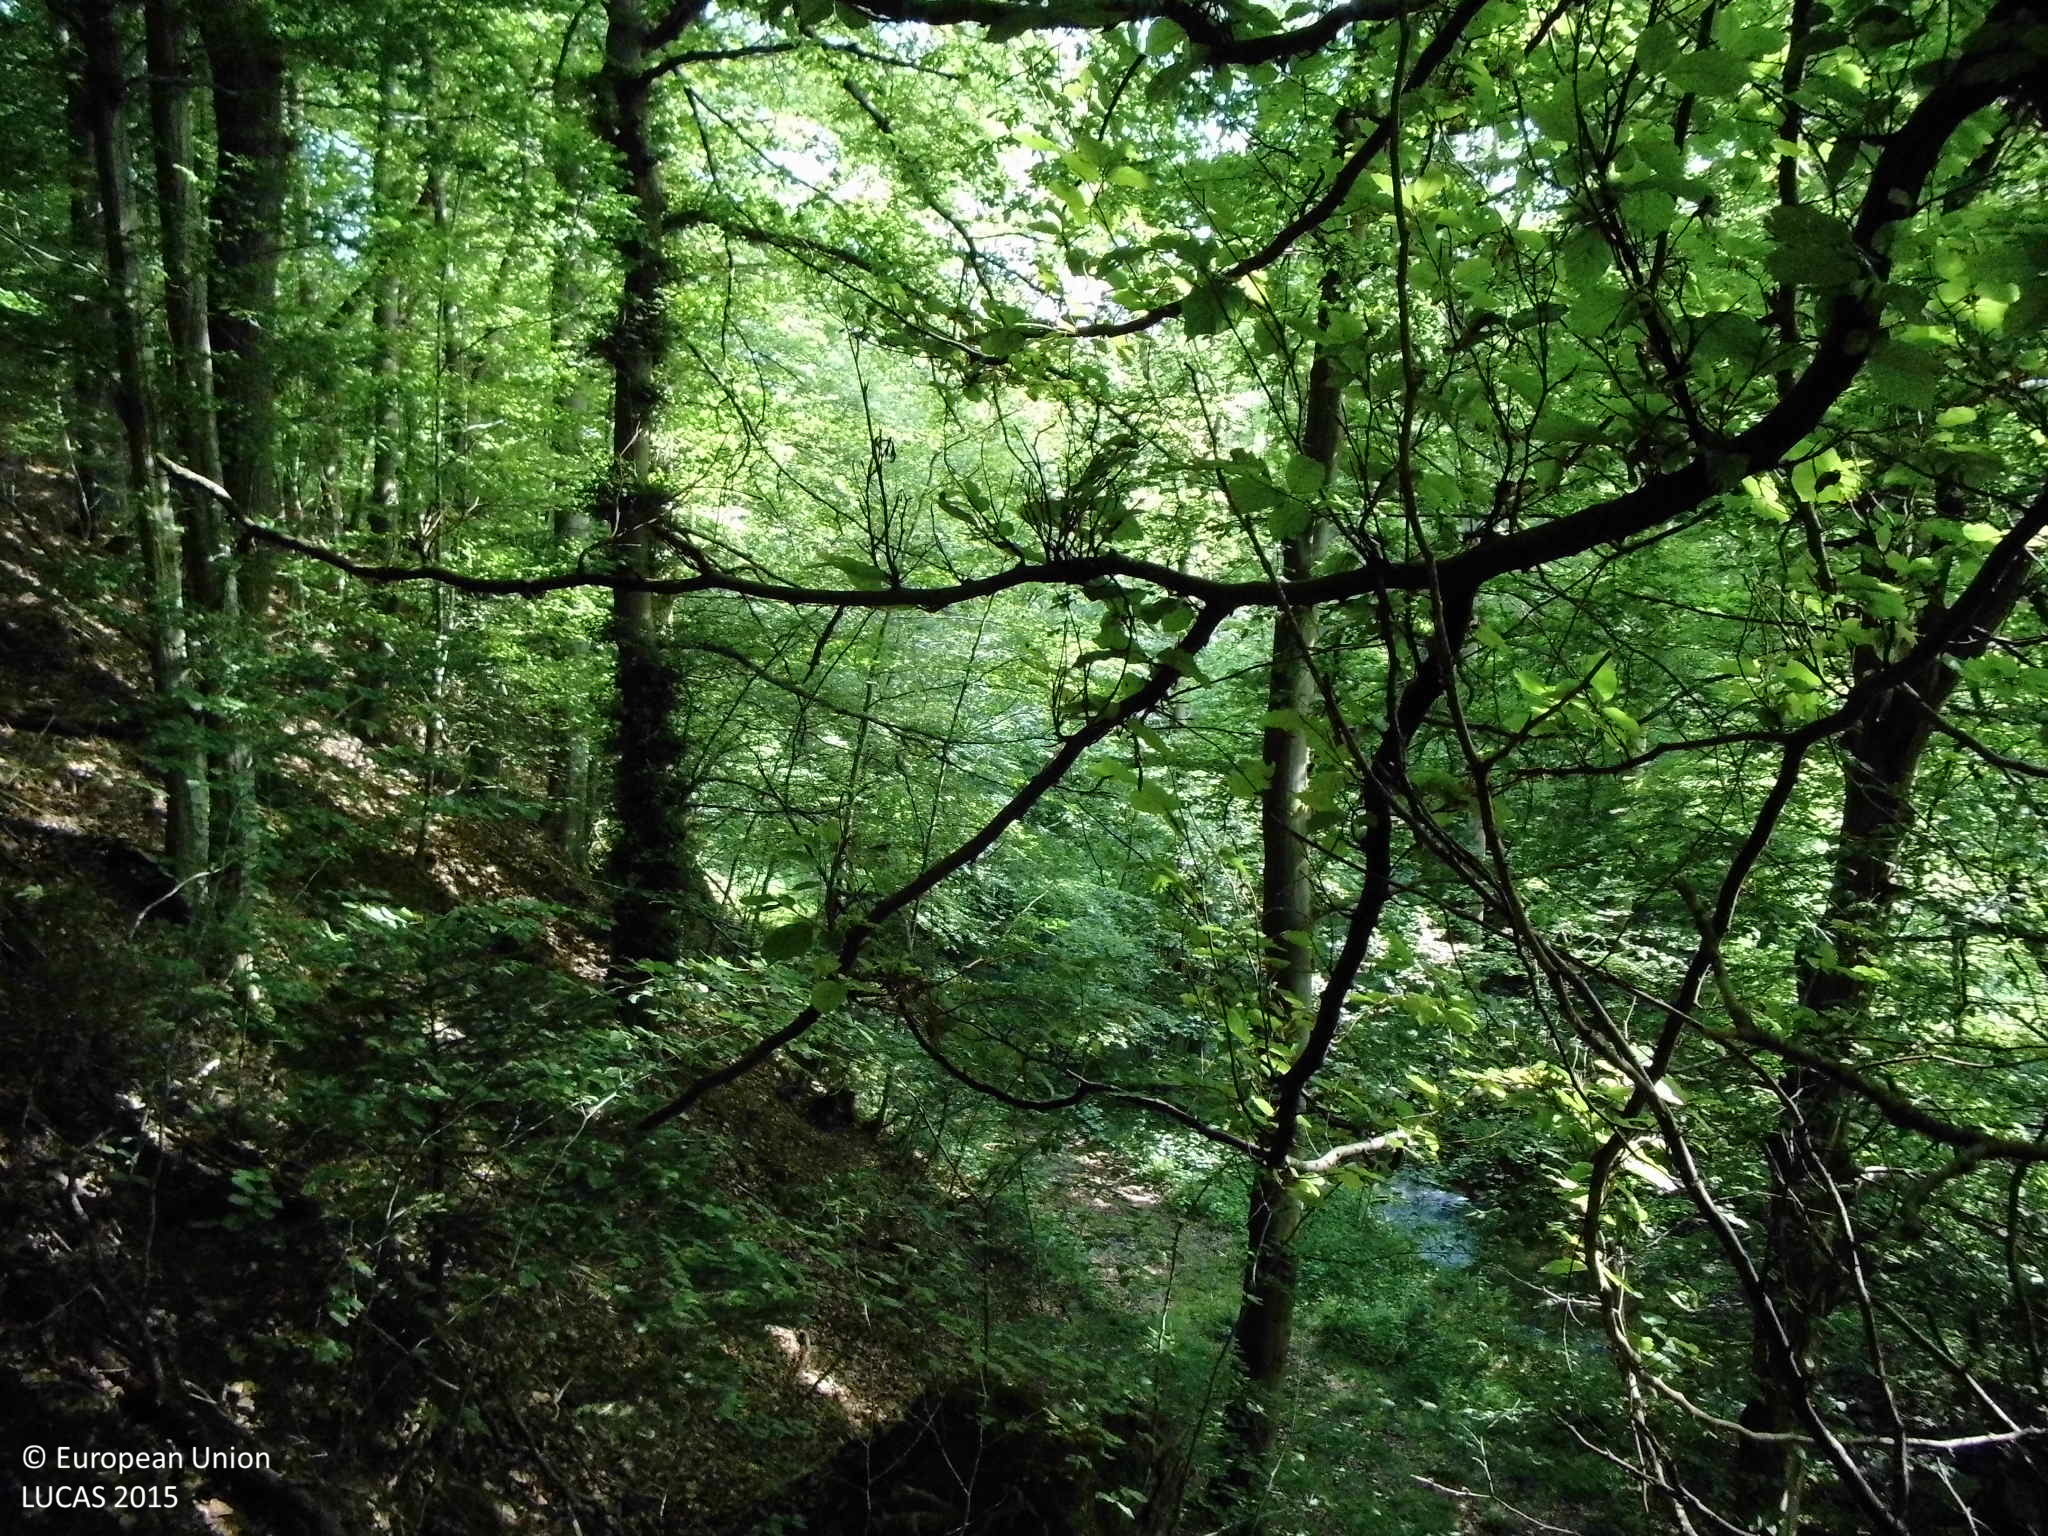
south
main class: Woodland
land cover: Broadleaved woodland
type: beech forest
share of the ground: > 75 %
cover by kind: broadleaved forest trees 90 %, coniferous forest trees 10 %
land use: Forestry
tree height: > 5 m
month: June
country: DE
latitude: 50.7491
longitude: 7.4349
